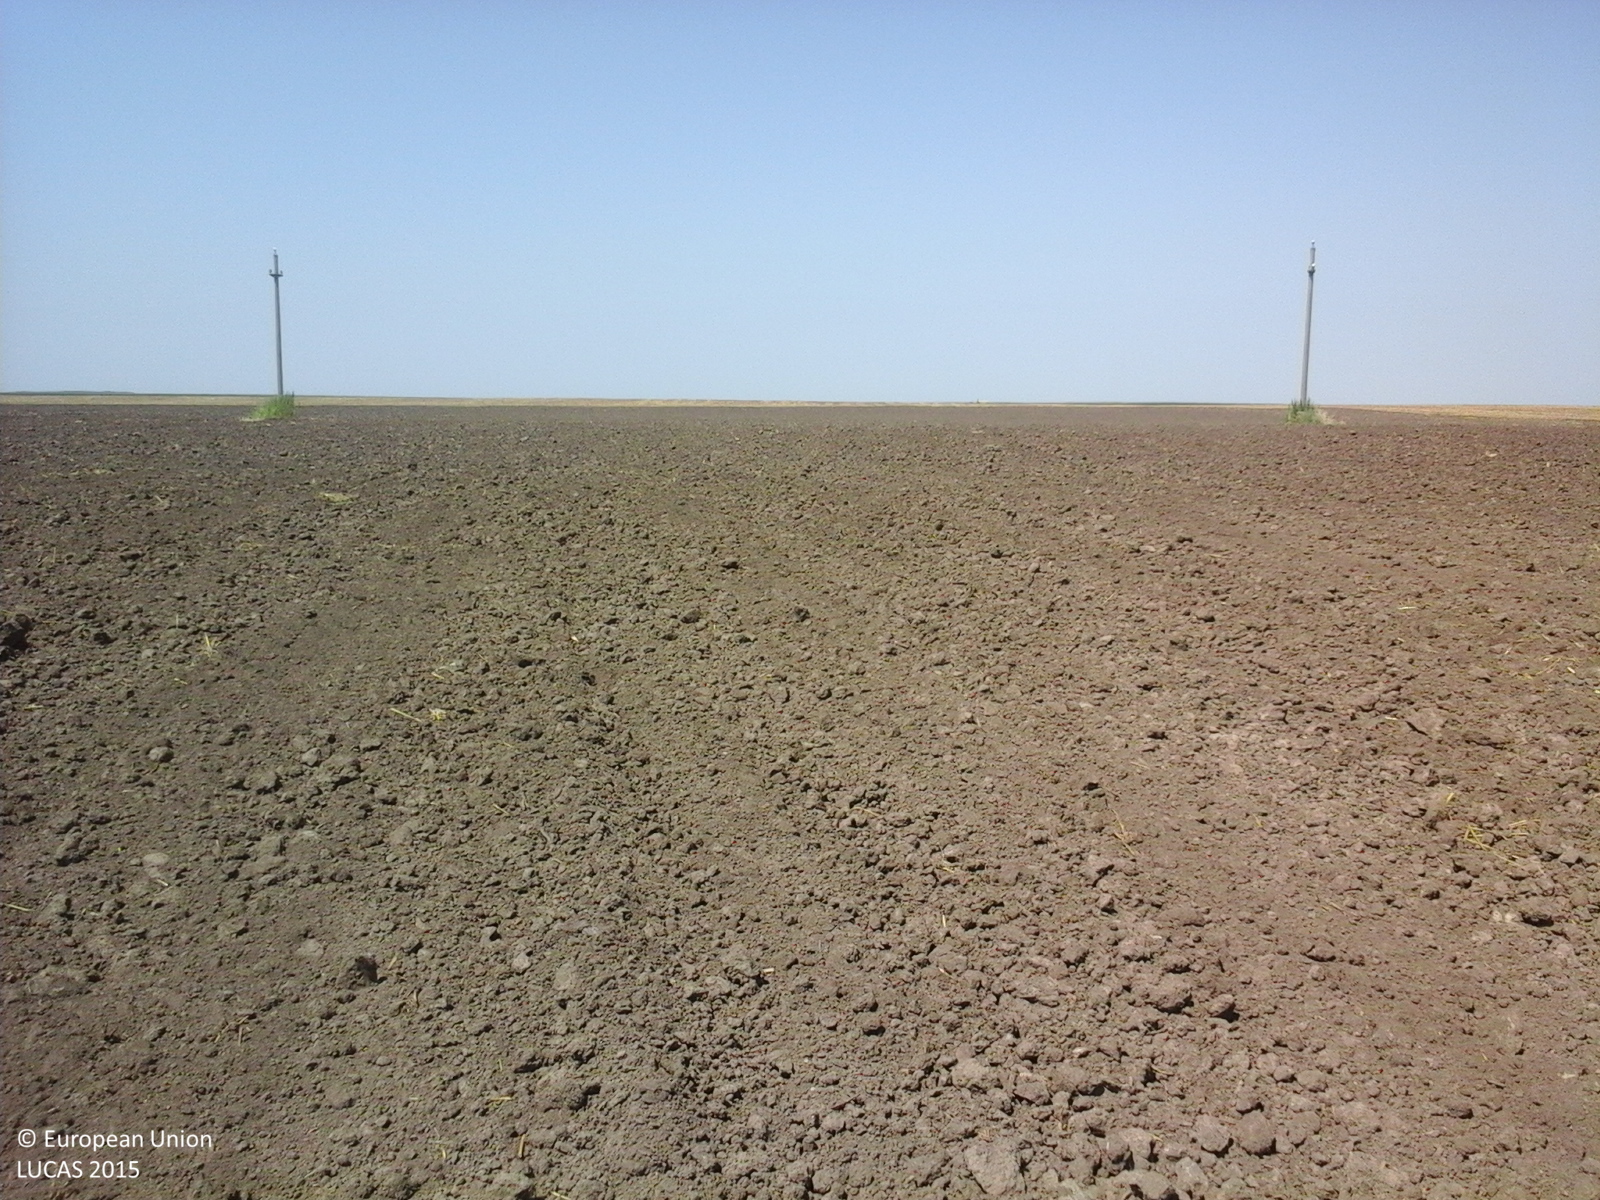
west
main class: Cropland
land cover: Durum wheat
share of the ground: < 10 %
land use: Agriculture (excluding fallow land and kitchen gardens)
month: July
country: RO
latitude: 44.4972
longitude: 27.1229
